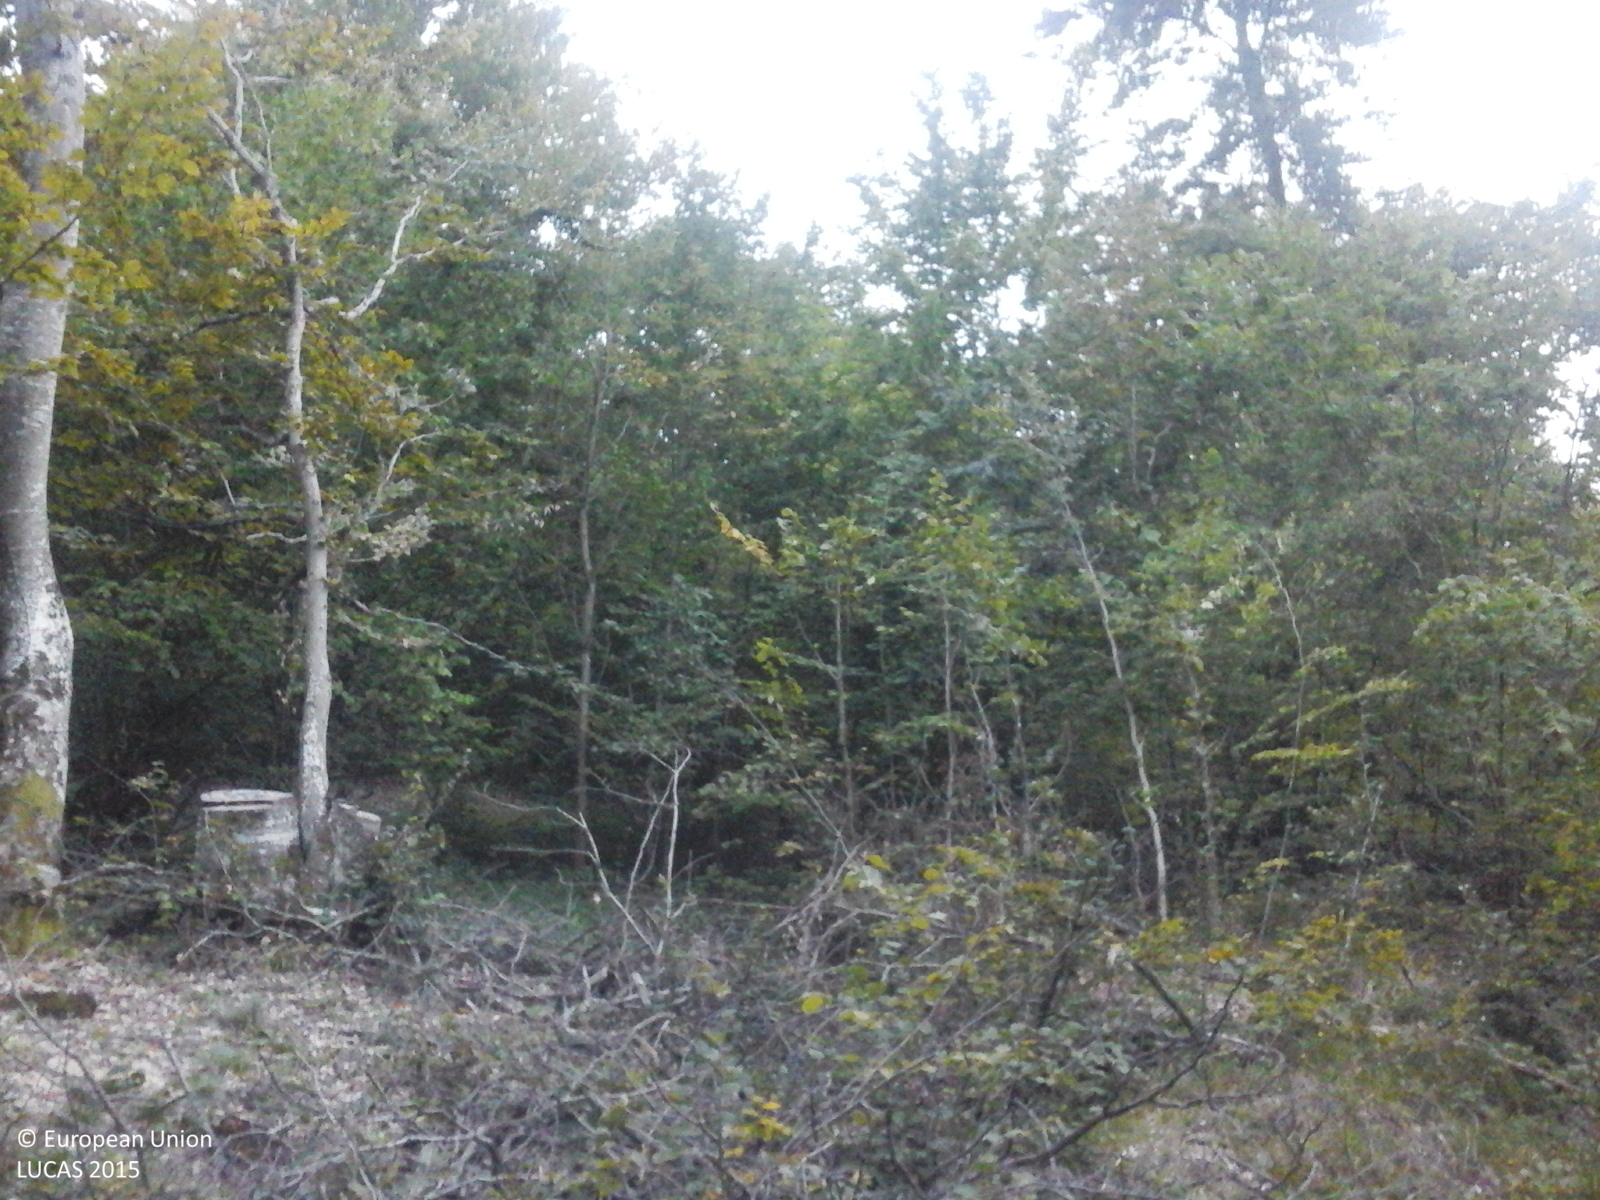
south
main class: Woodland
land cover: Broadleaved woodland
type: beech forest
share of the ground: > 75 %
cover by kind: broadleaved forest trees 100 %
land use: Forestry
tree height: > 5 m
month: September
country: RO
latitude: 46.7115
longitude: 23.3701
